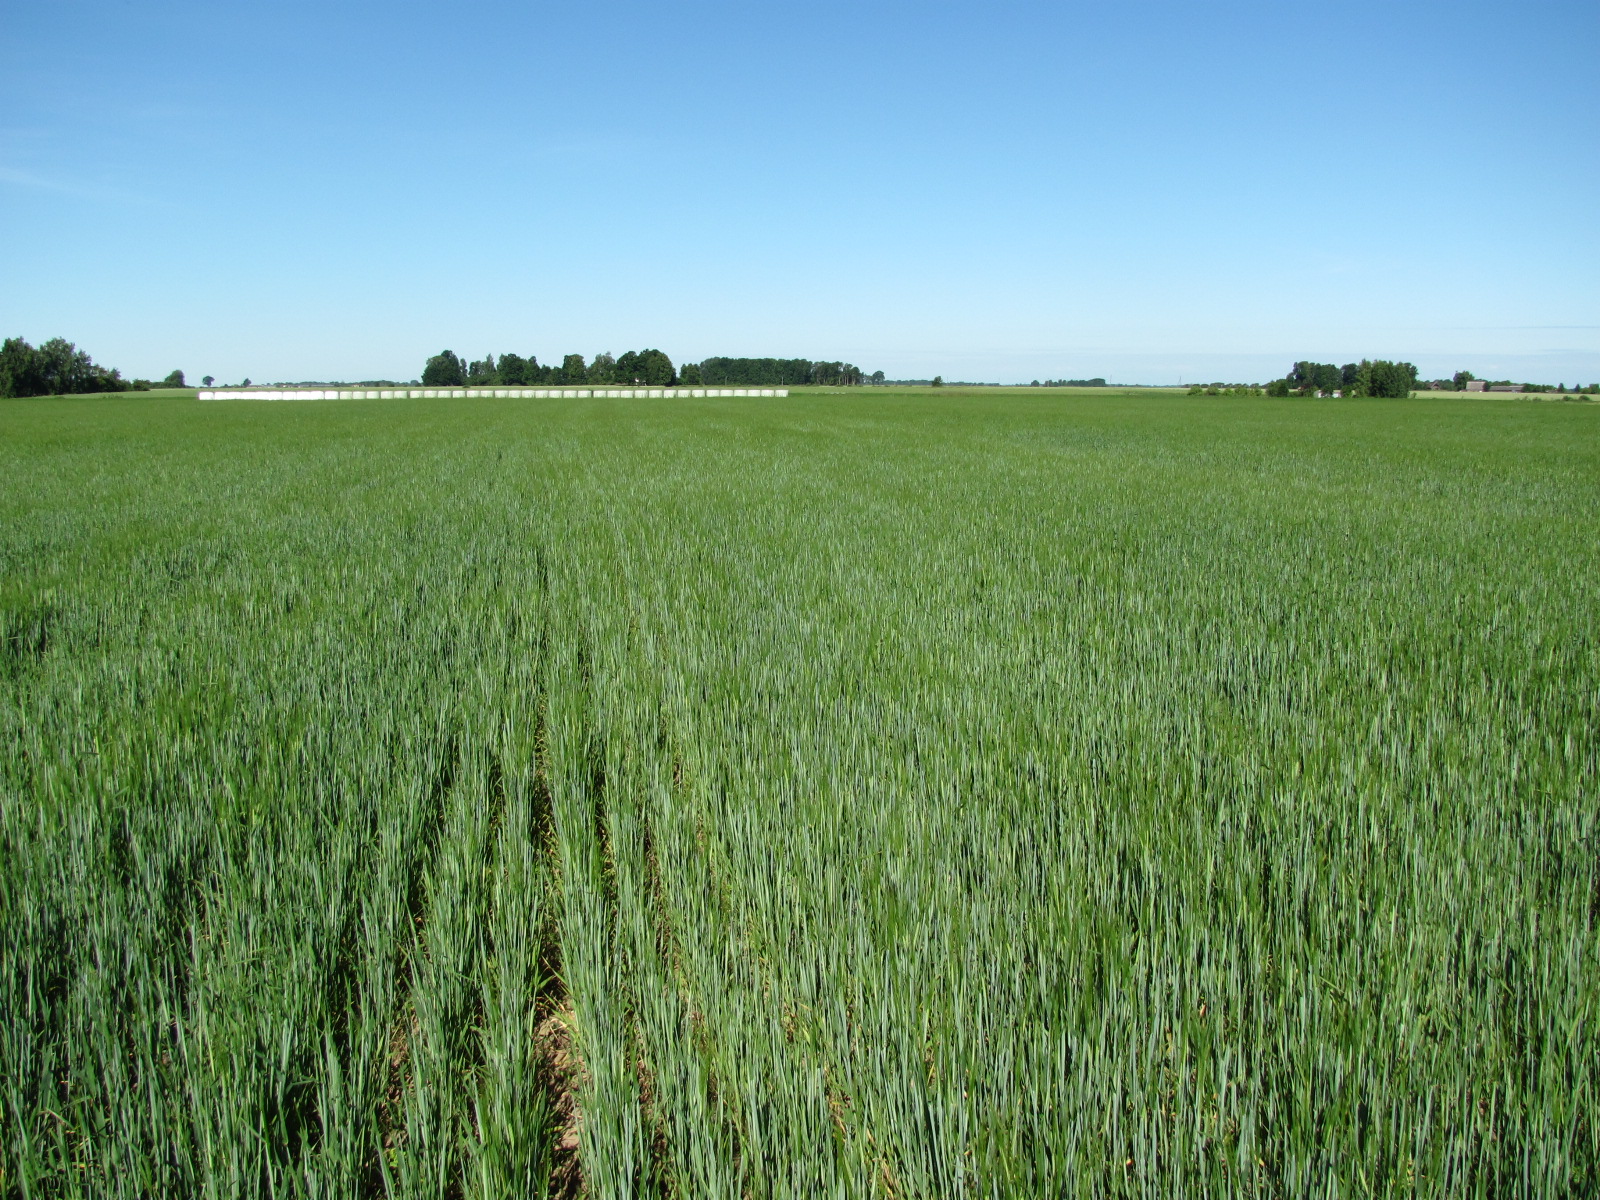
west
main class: Cropland
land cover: Barley
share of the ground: > 75 %
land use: Agriculture (excluding fallow land and kitchen gardens)
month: July
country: LV
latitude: 56.5105
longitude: 23.8455
